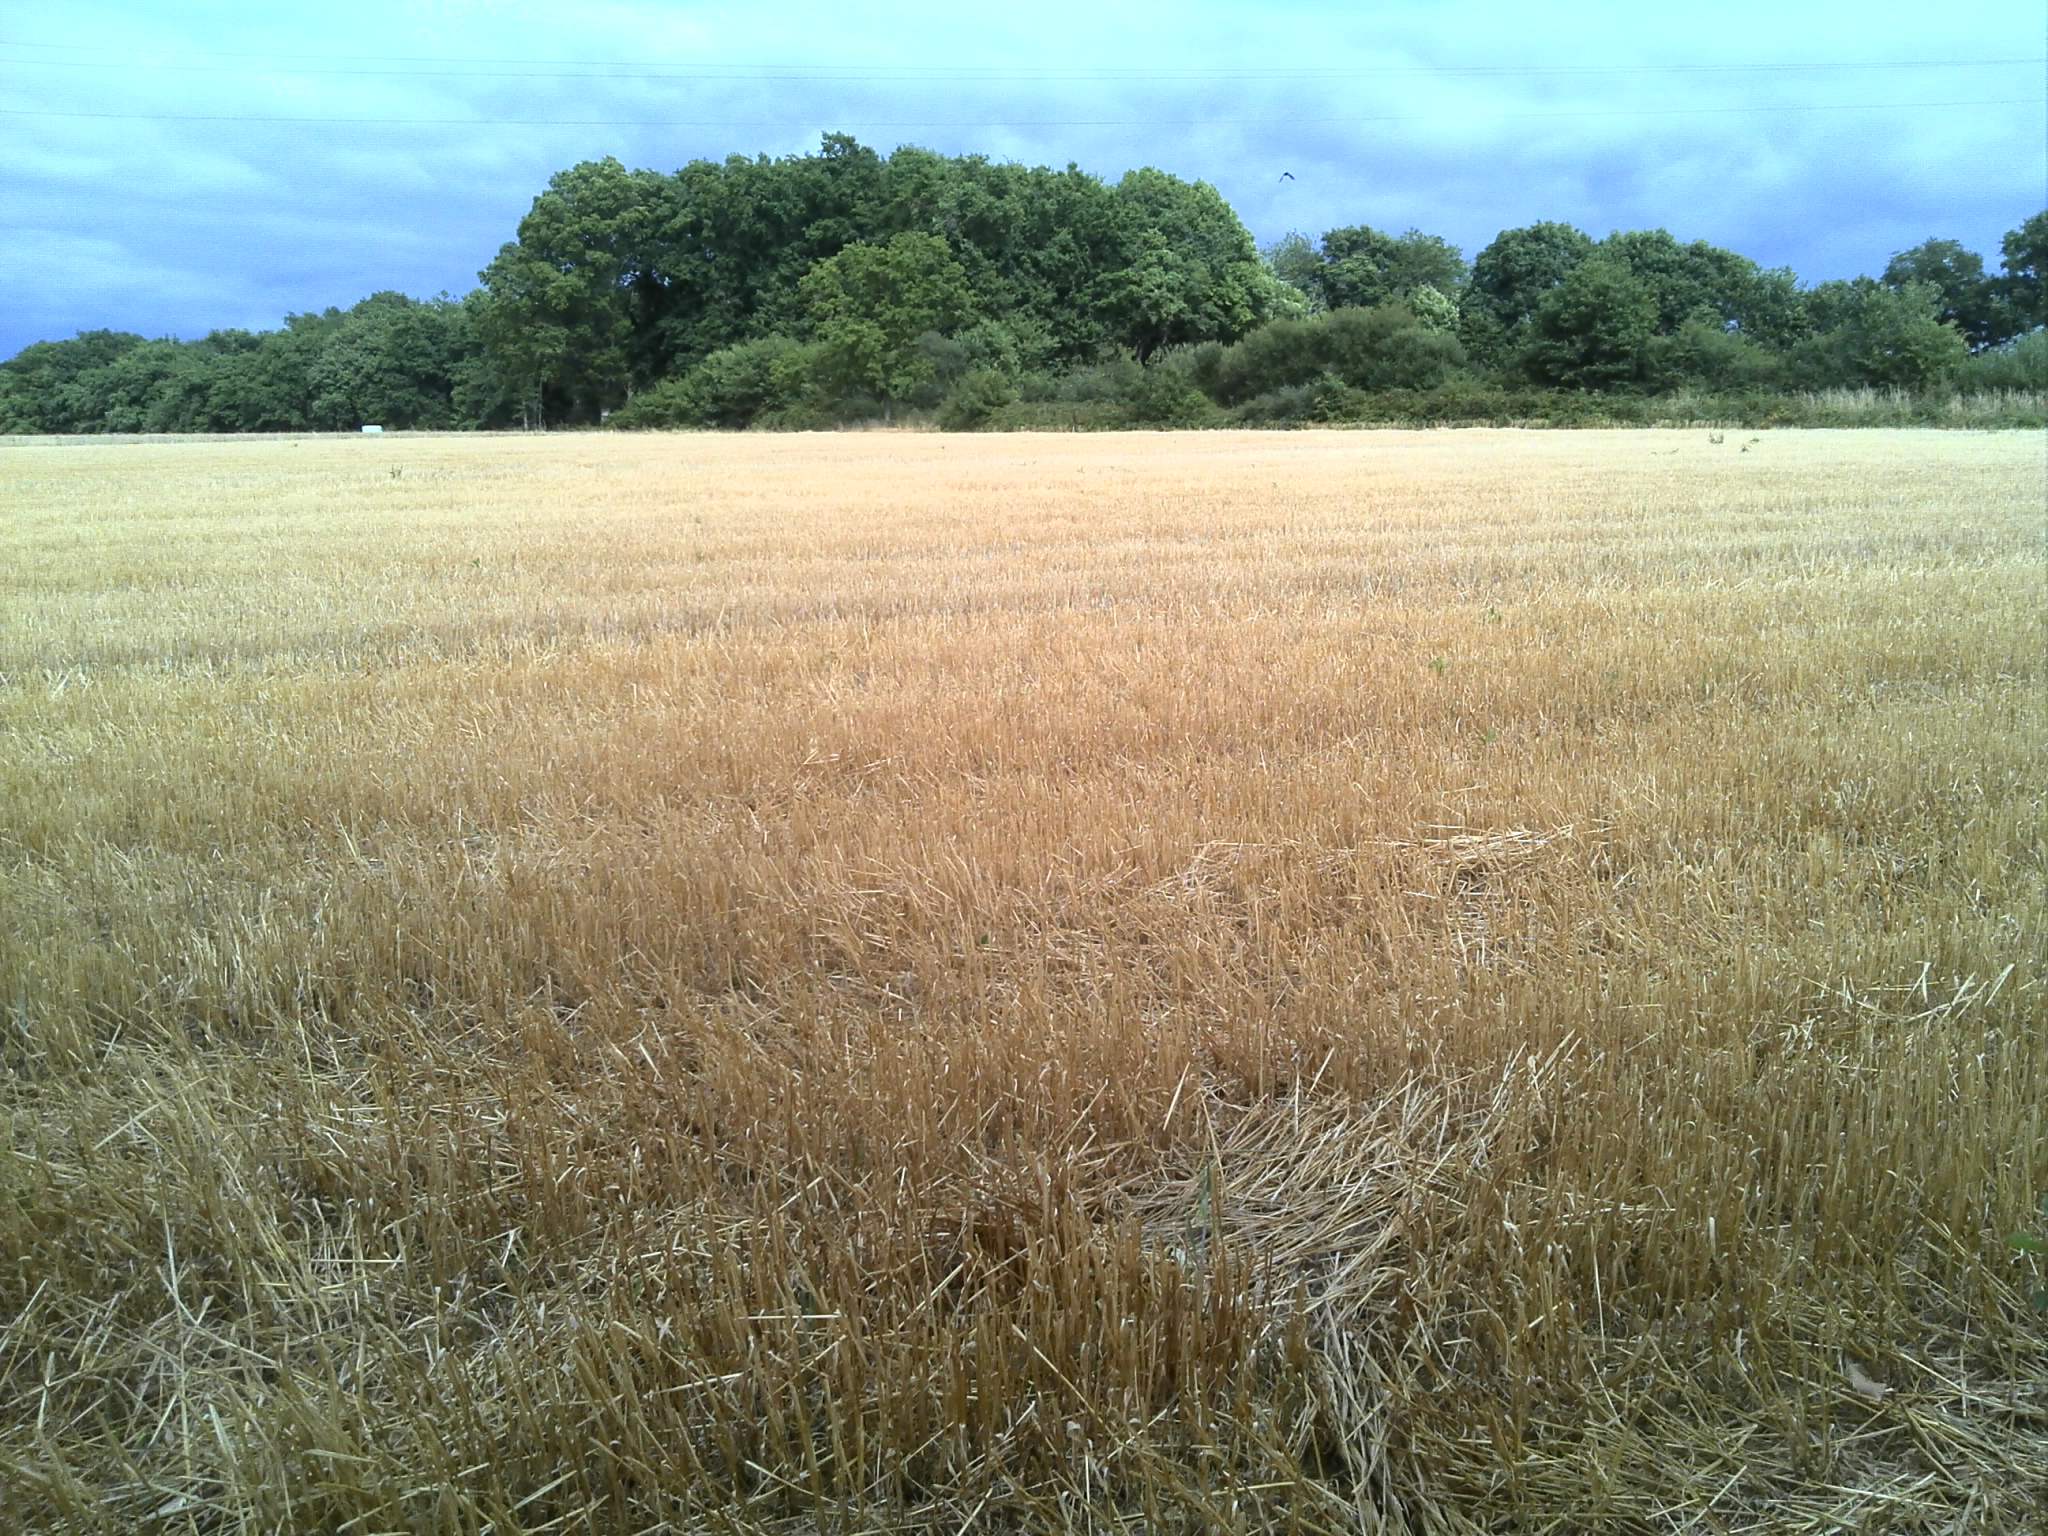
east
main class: Cropland
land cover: Barley
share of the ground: > 75 %
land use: Agriculture (excluding fallow land and kitchen gardens)
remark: Harvested field
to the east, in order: Abandoned hedges; Barley; Electric lines; Barley; Managed hedges; Tracks; Abandoned hedges; Fences; Temporary grasslands; Fences; Broadleaved woodland; Shrubland without tree cover
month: July
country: FR
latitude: 46.4681
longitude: 1.5384
